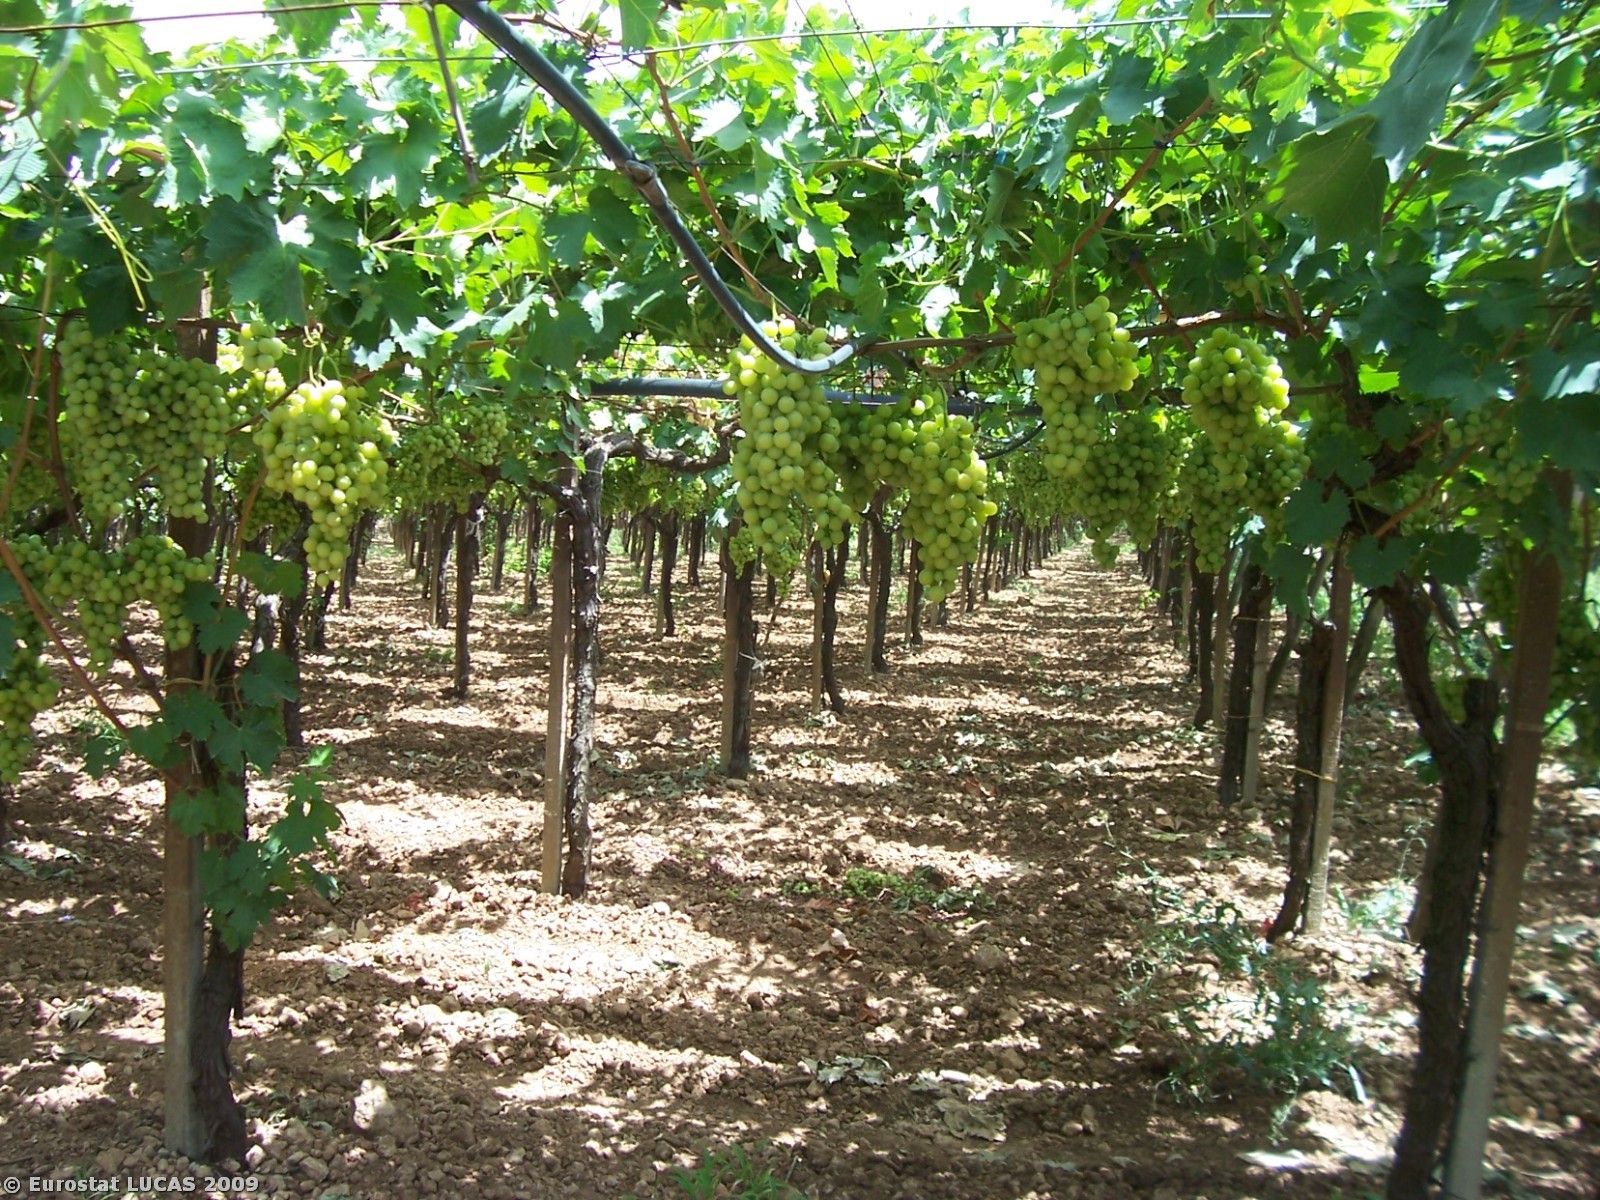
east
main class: Cropland
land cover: Vineyards
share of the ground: > 75 %
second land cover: Bare land
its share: > 75 %
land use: Agriculture (excluding fallow land and kitchen gardens)
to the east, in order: Vineyards; Bare land; Olive groves; Bare land; Paved roads, cycling and walking lanes; Grass margins; Electric lines; Olive groves; Bare land; Tracks; Vineyards; Bare land
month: July
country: IT
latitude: 40.6155
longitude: 17.0094
